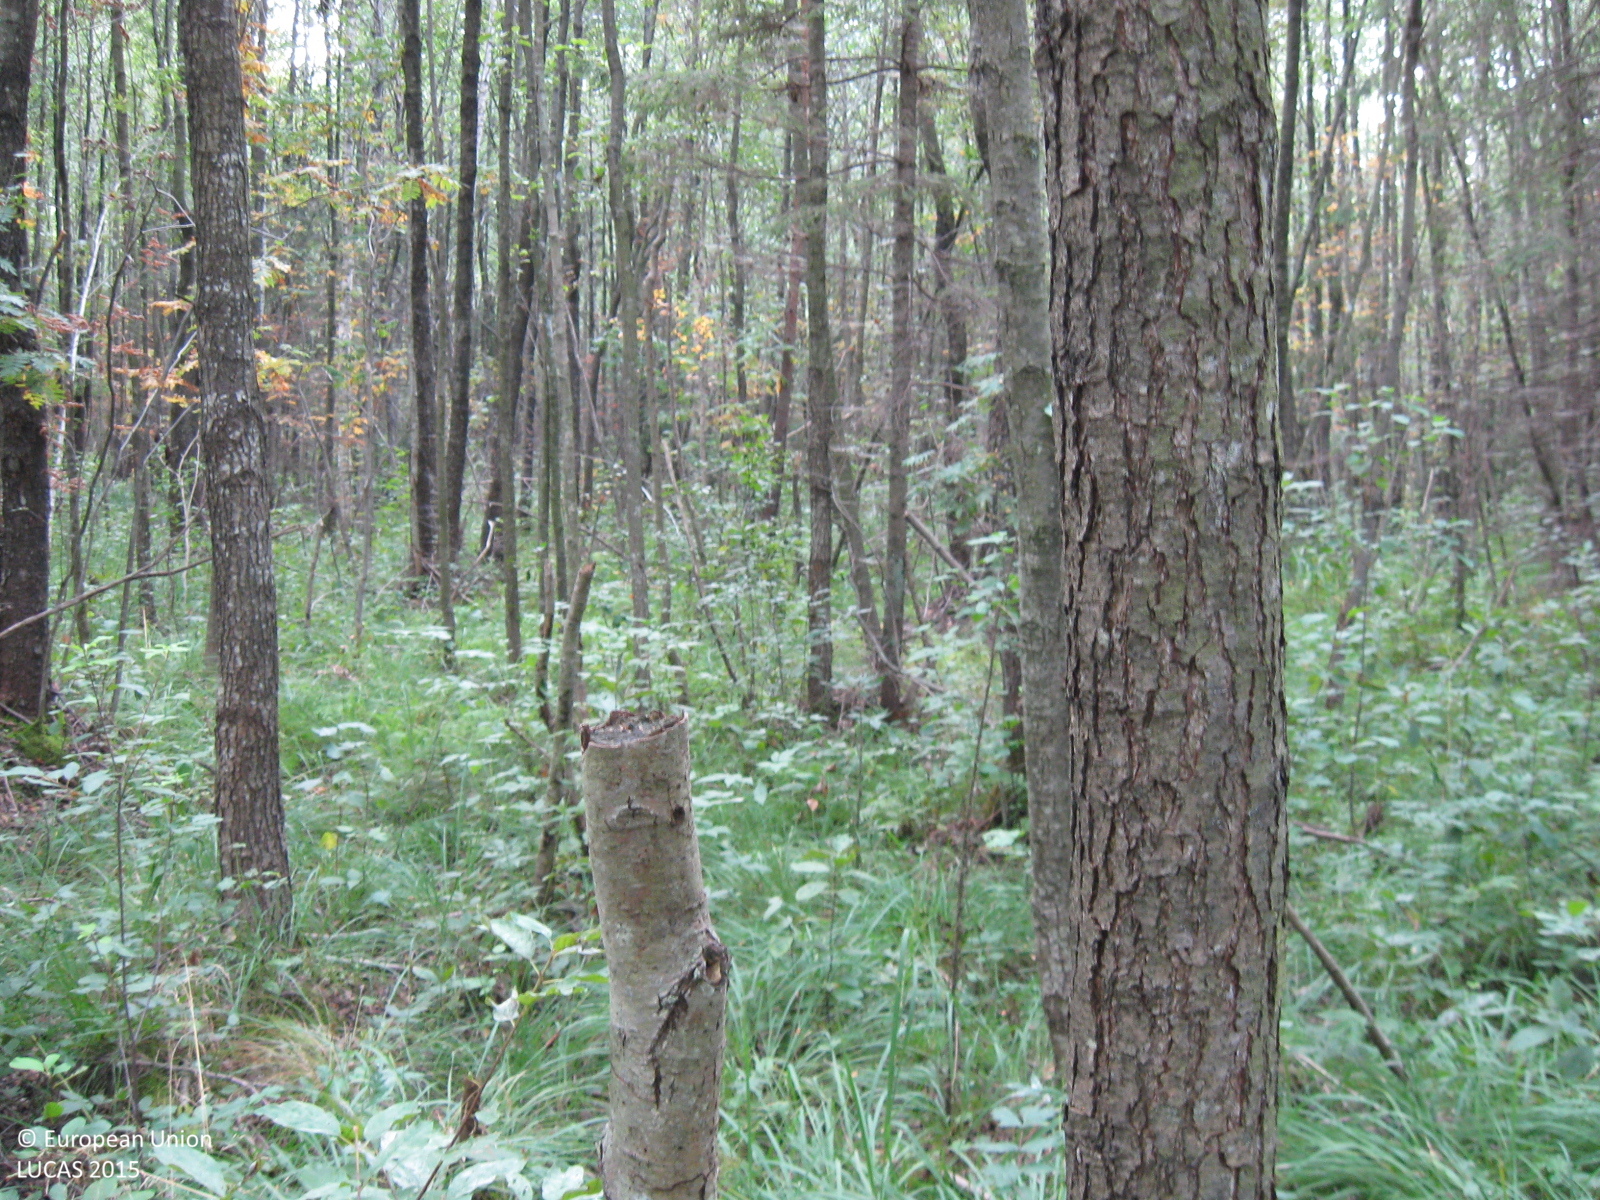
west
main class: Woodland
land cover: Broadleaved woodland
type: non-riverine alder, birch or aspen forest
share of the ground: > 75 %
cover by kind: broadleaved forest trees 85 %, herbaceous plants 10 %, coniferous forest trees 5 %
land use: Forestry
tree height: > 5 m
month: August
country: LT
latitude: 55.5770
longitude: 23.3522
